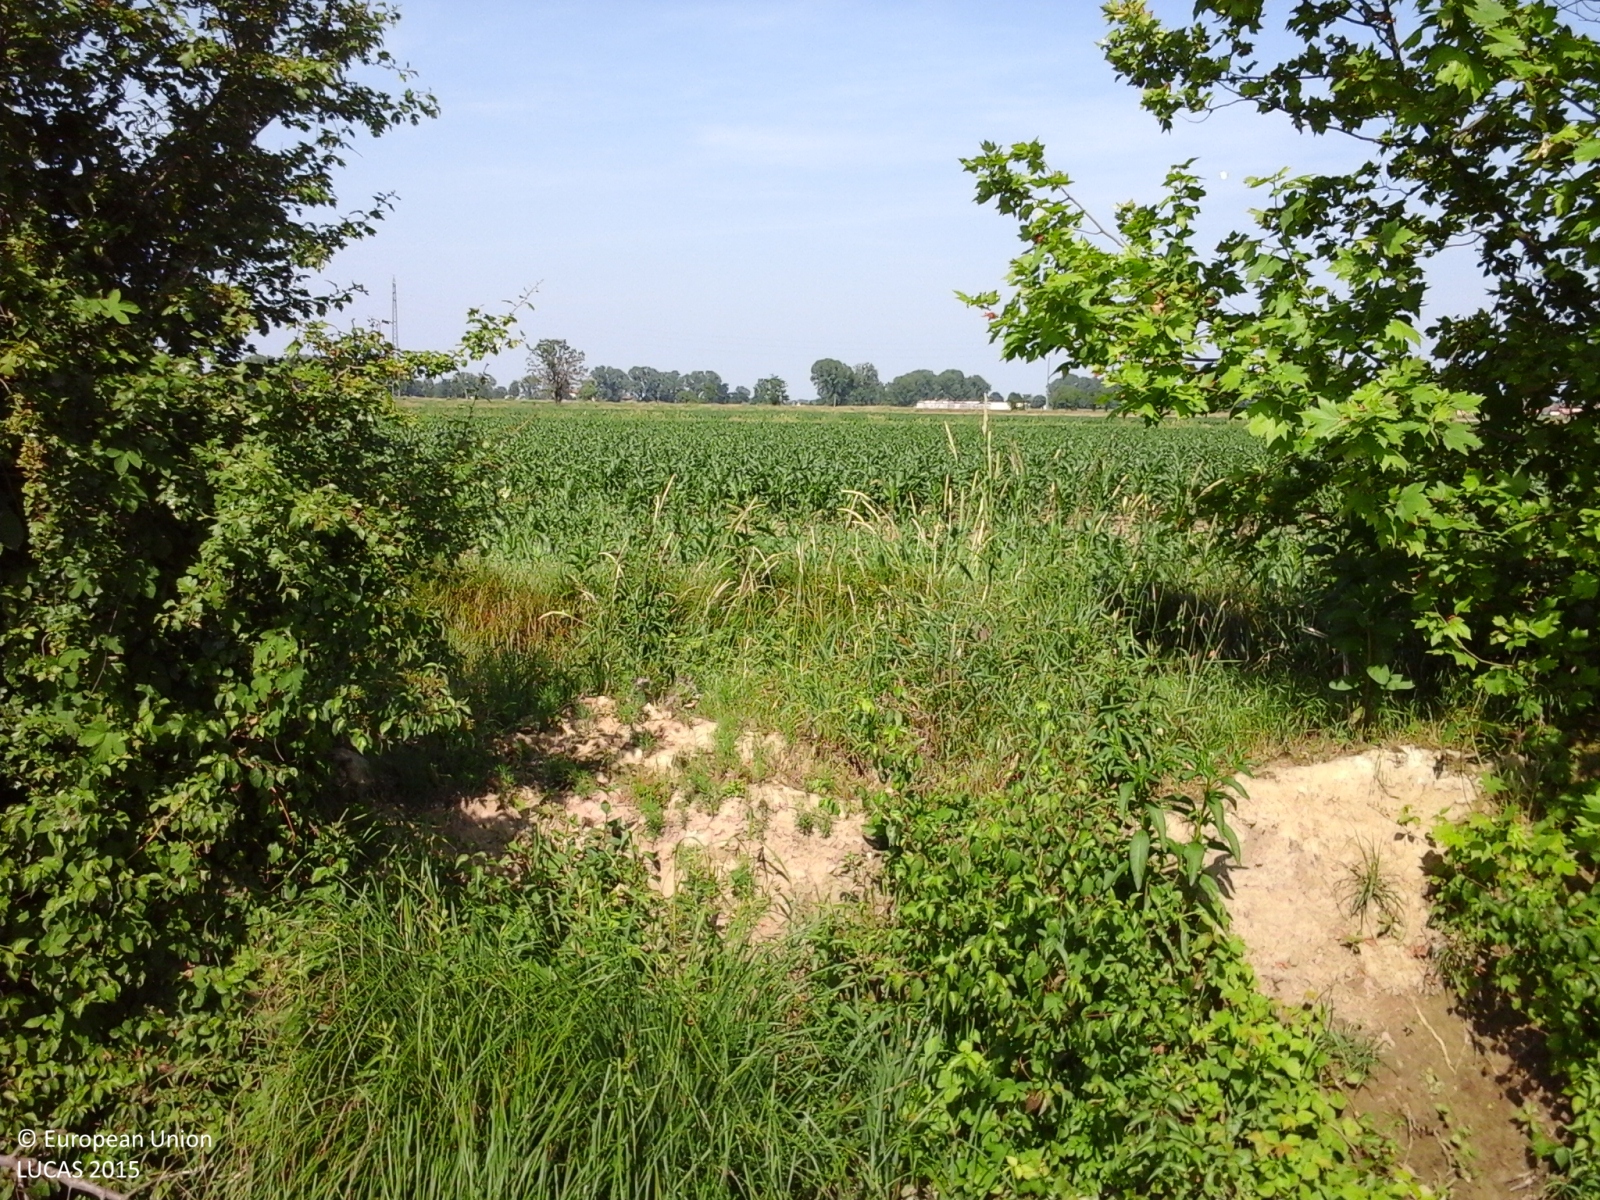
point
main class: Cropland
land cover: Maize
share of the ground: > 75 %
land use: Agriculture (excluding fallow land and kitchen gardens)
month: May
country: IT
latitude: 45.2151
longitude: 9.5552
